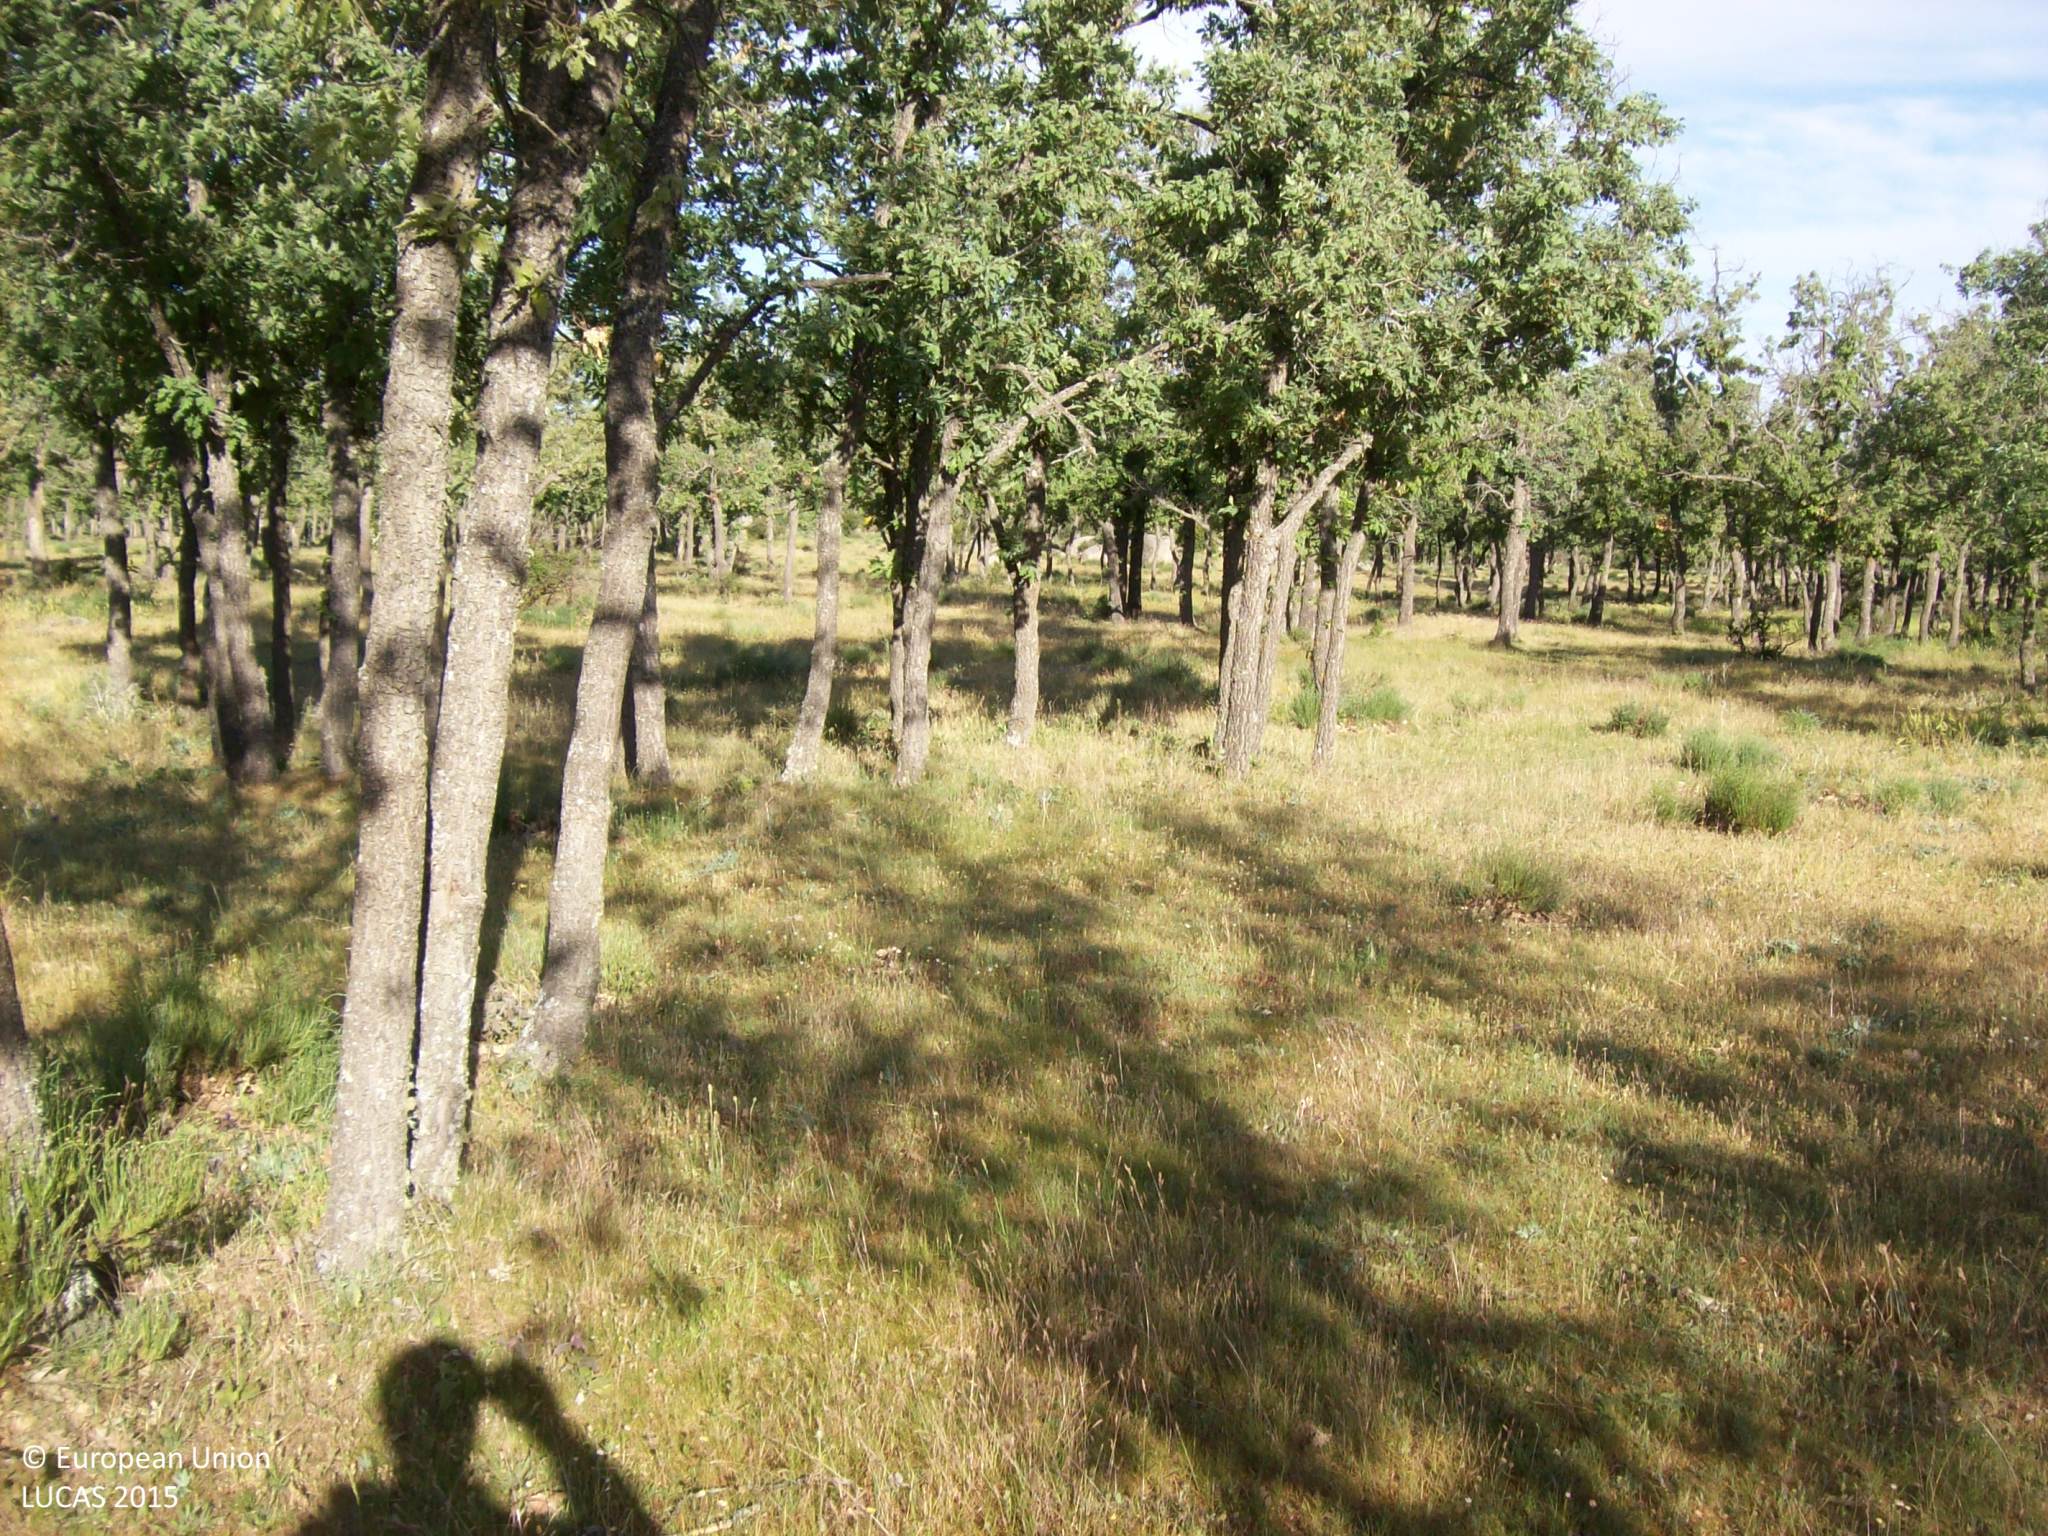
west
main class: Woodland
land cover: Broadleaved woodland
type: thermophilous deciduous forest
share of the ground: 25 - 50 %
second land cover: Grassland without tree/shrub cover
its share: > 75 %
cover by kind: herbaceous plants 55 %, broadleaved forest trees 40 %, shrubs 5 %
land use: Forestry
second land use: Agriculture (excluding fallow land and kitchen gardens)
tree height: < 5 m
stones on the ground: < 10 %
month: May
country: ES
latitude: 40.7690
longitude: -4.4474
